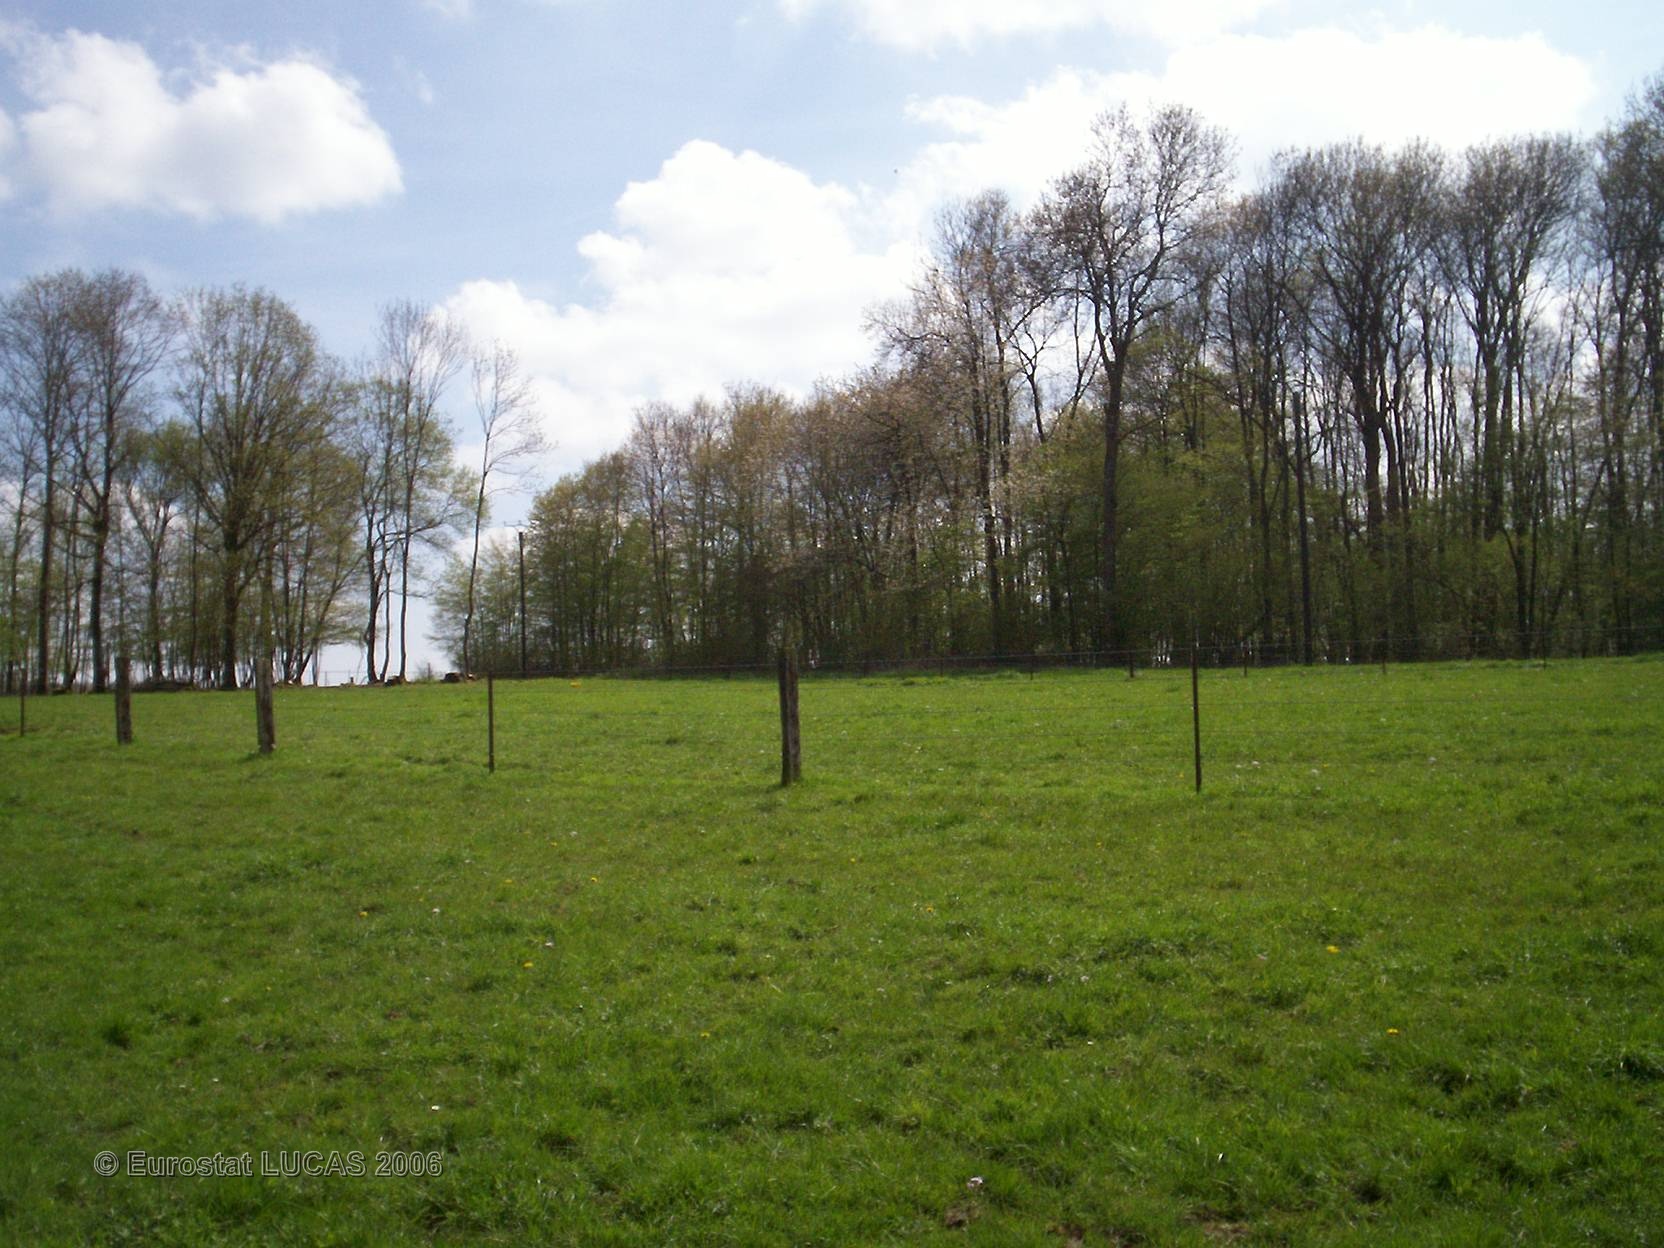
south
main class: Grassland
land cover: Grassland without tree/shrub cover
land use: Agriculture (excluding fallow land and kitchen gardens)
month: May
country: FR
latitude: 49.8286
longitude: 4.3655
